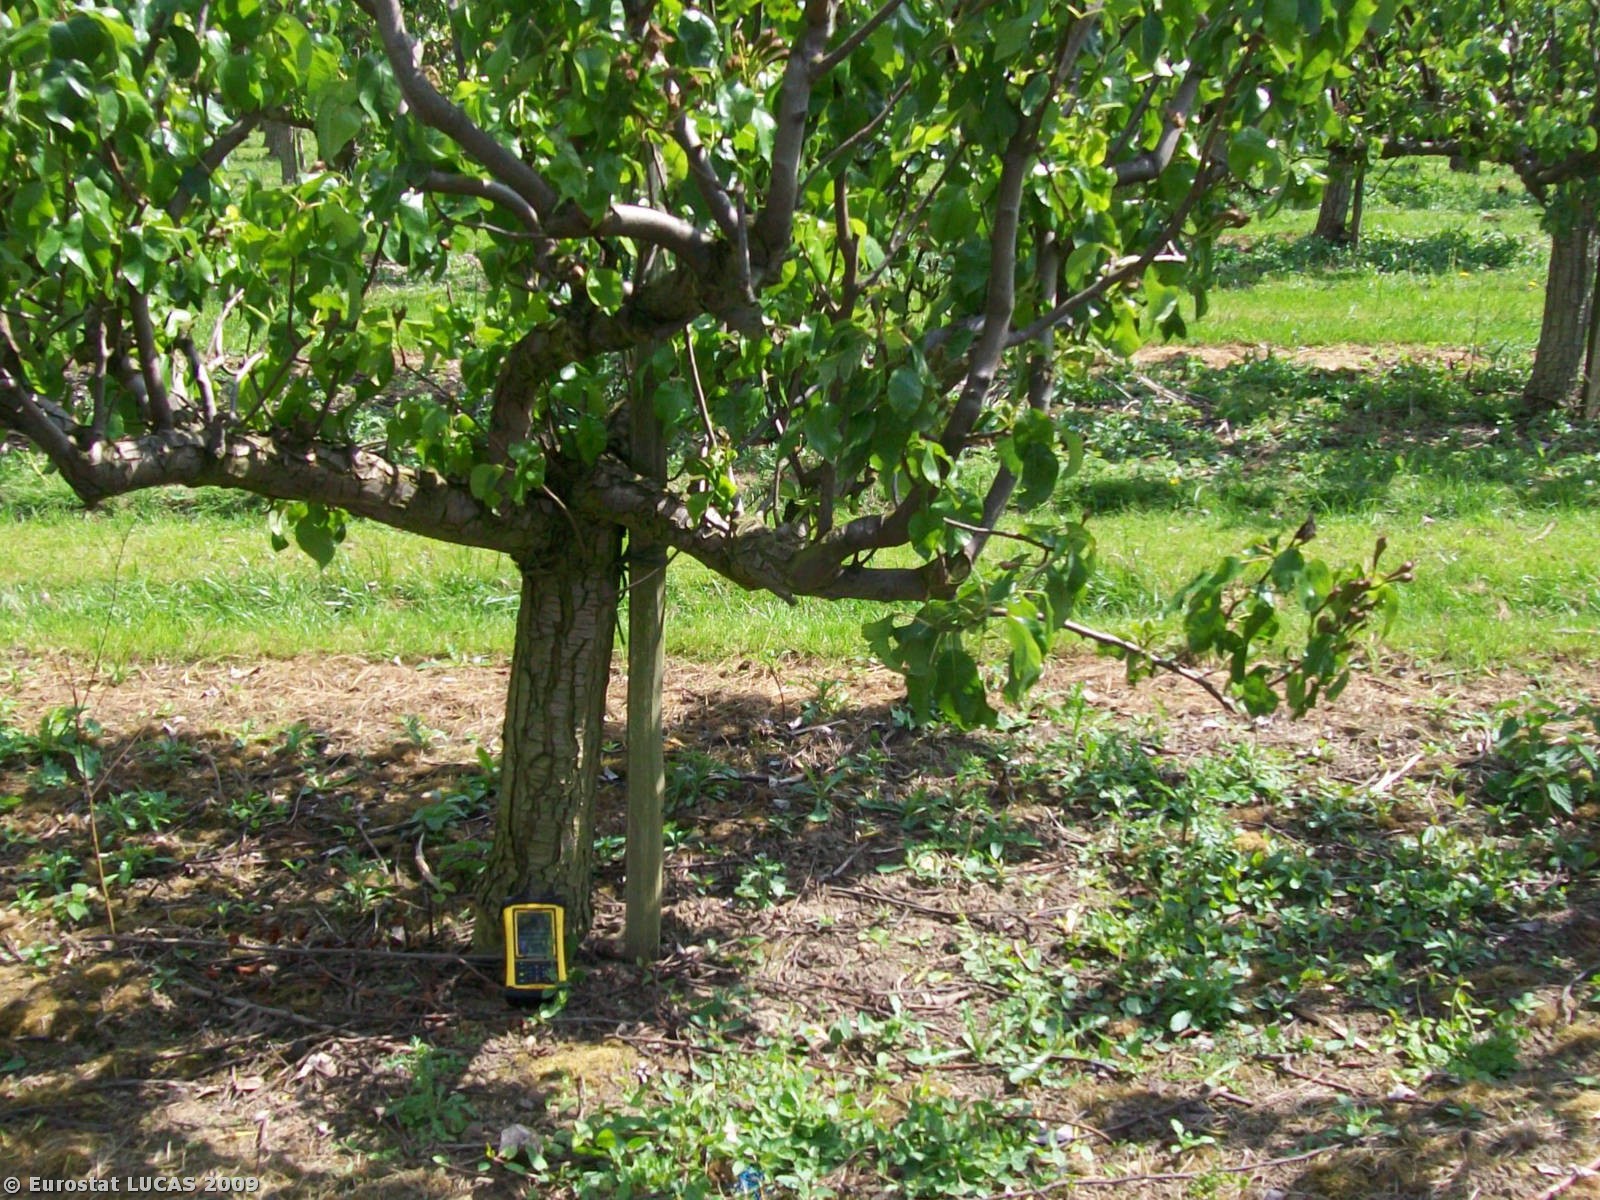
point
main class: Cropland
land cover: Apple fruit
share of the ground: > 75 %
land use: Agriculture (excluding fallow land and kitchen gardens)
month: May
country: GB
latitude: 51.2726
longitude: 0.2946
